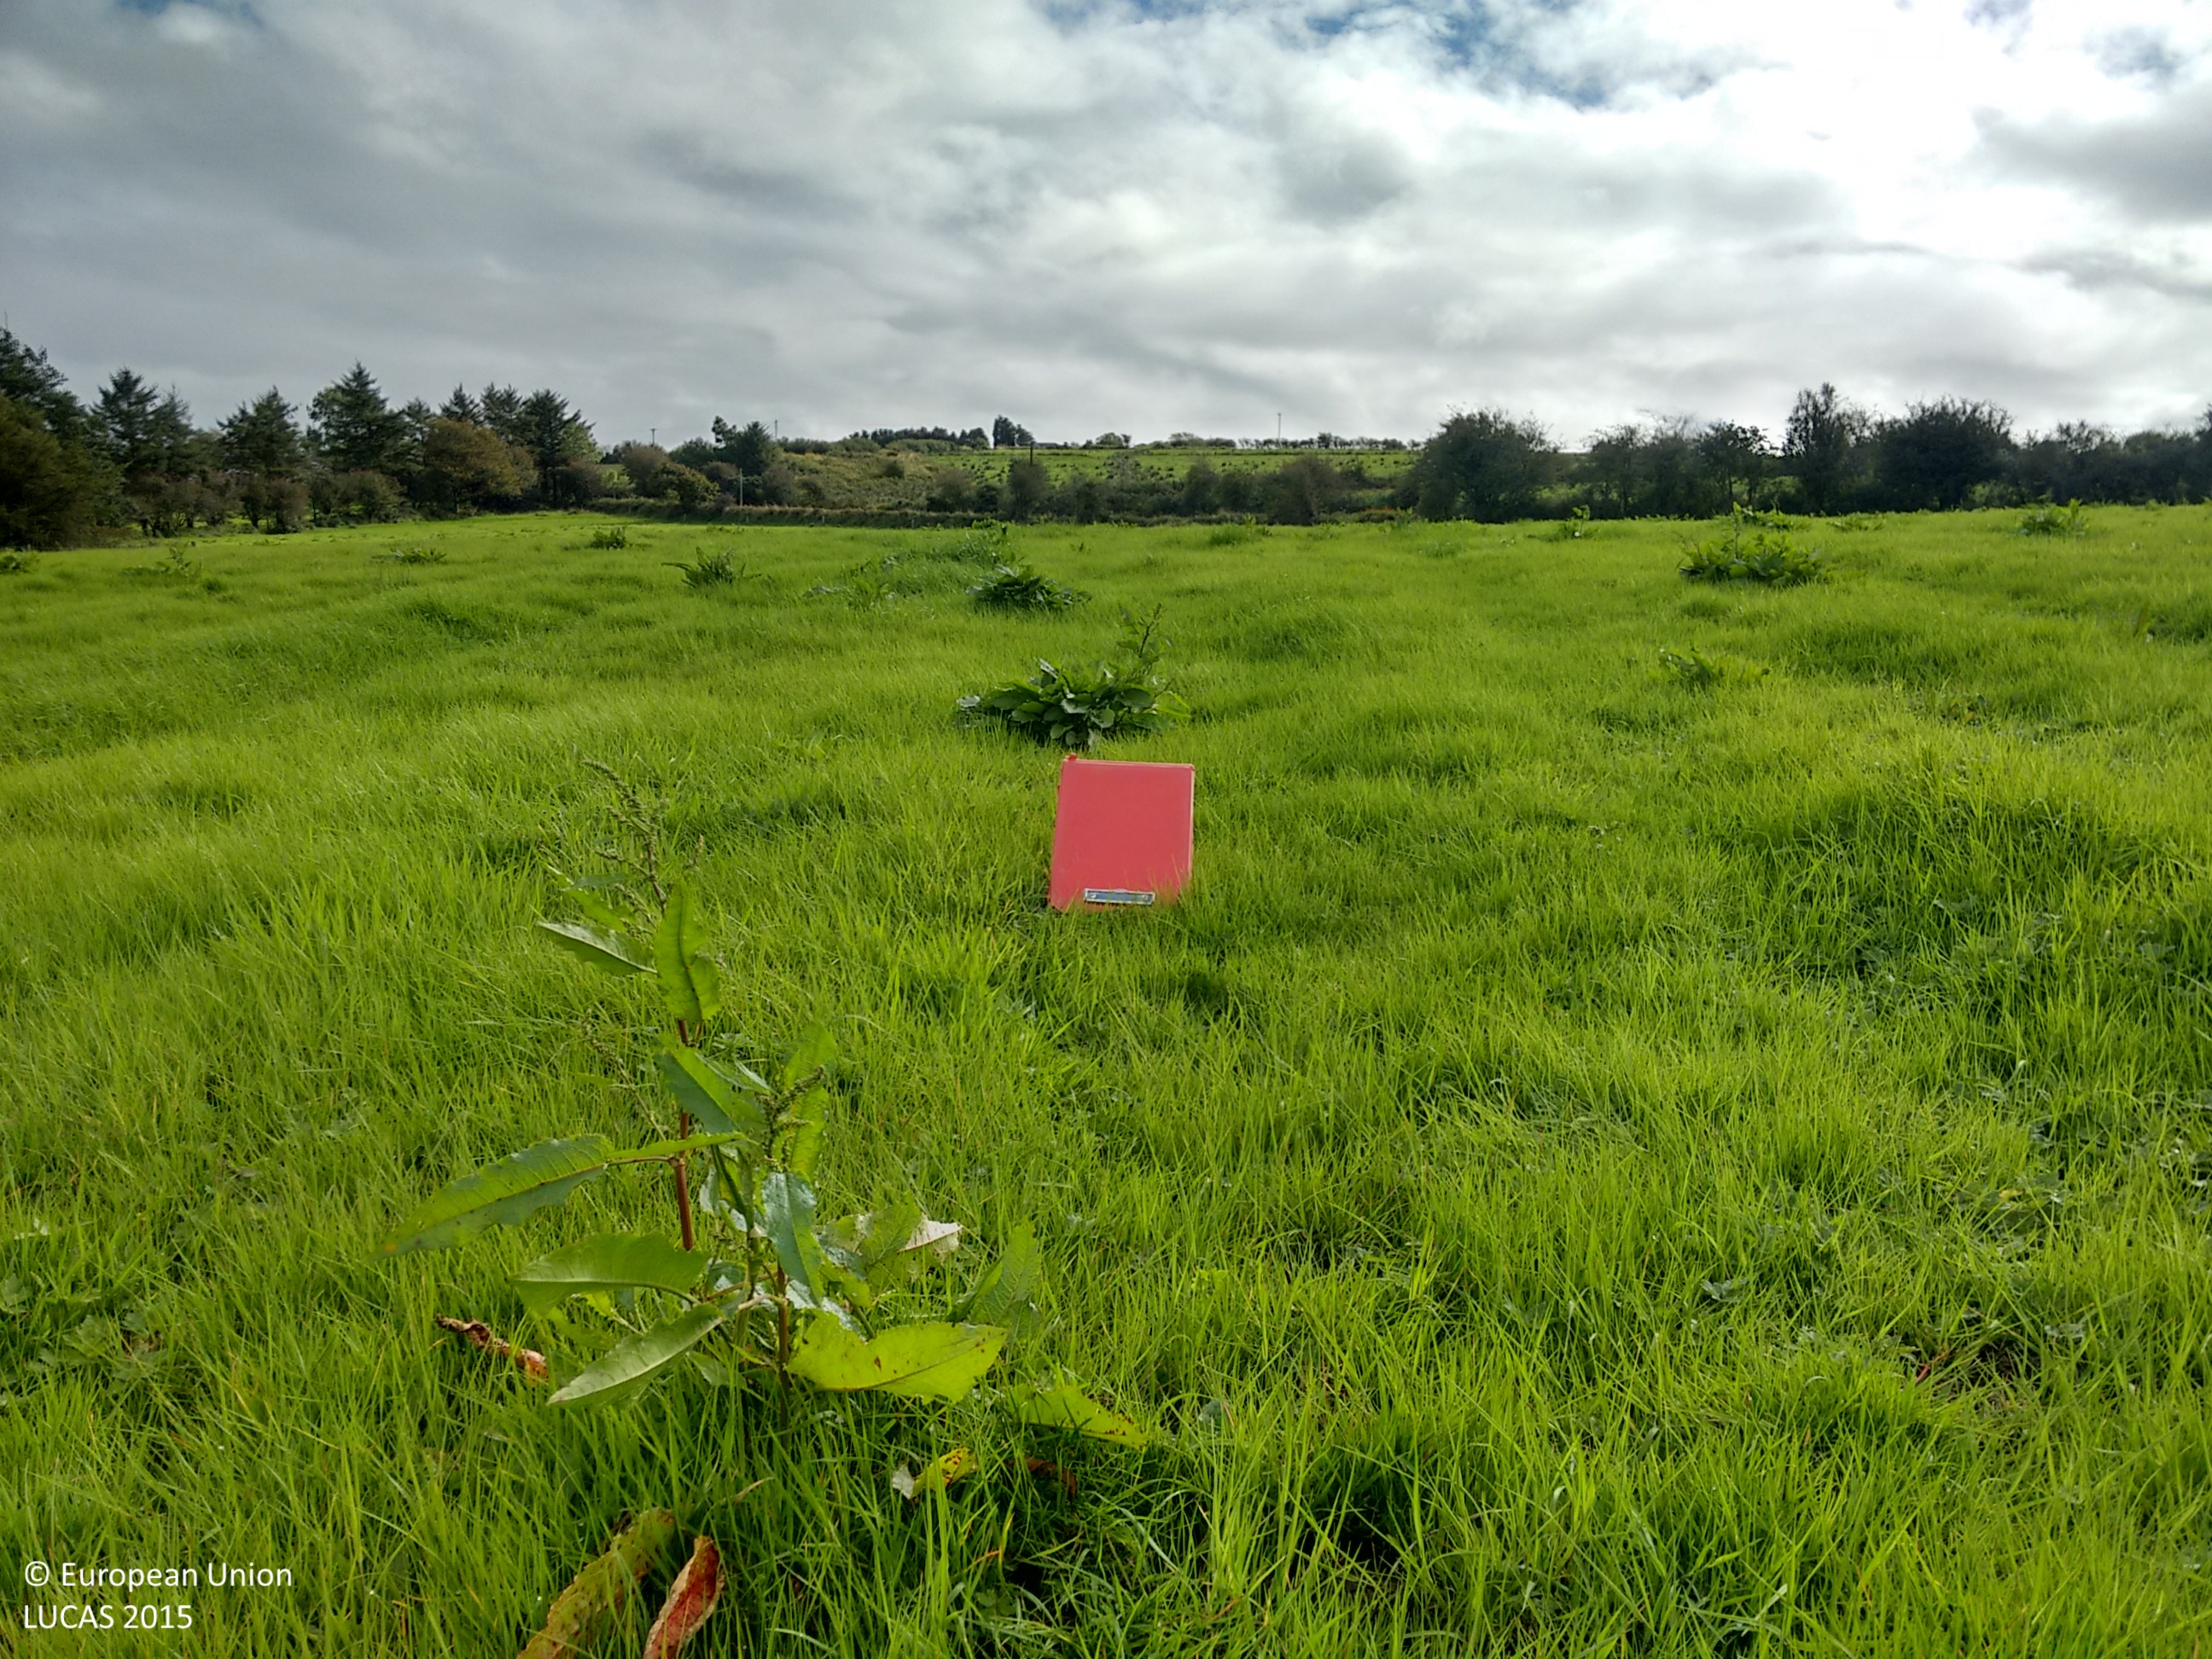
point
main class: Grassland
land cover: Grassland without tree/shrub cover
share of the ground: > 75 %
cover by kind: herbaceous plants 95 %, shrubs 5 %
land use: Agriculture (excluding fallow land and kitchen gardens)
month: September
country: IE
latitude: 52.3728
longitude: -9.2441
